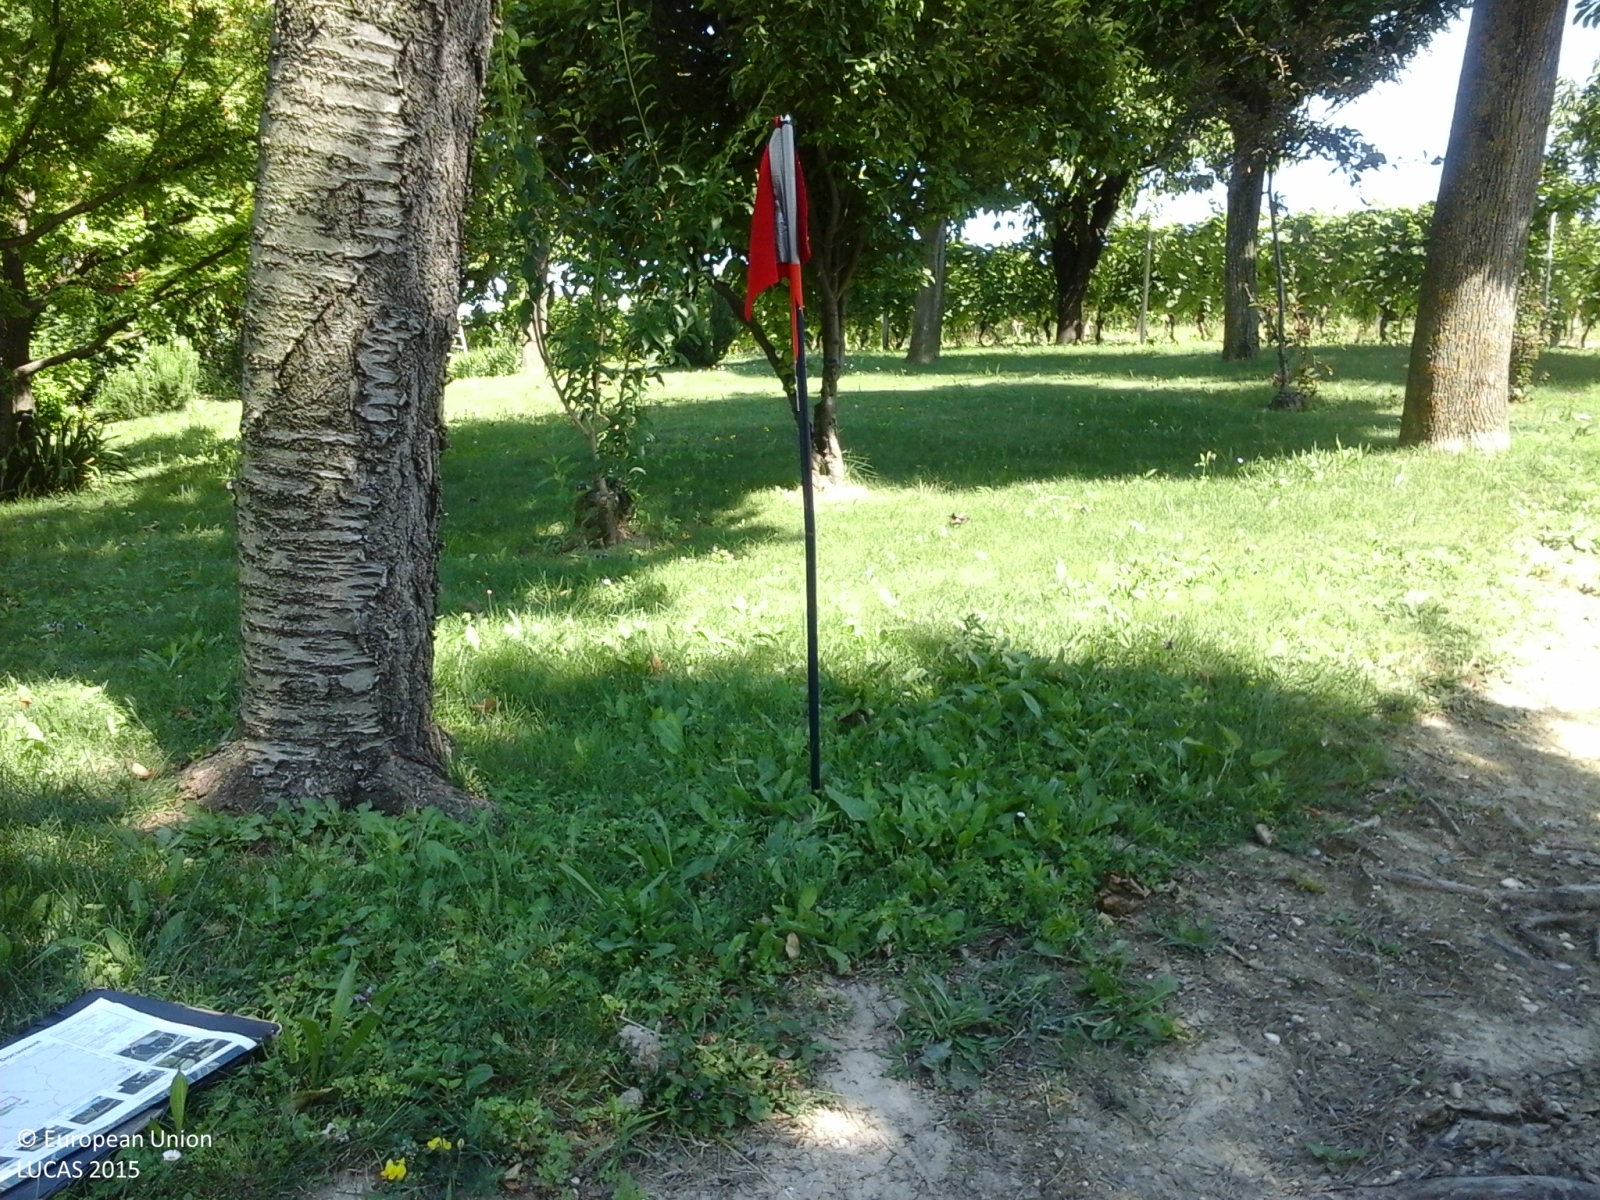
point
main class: Woodland
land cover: Broadleaved woodland
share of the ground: > 75 %
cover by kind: broadleaved forest trees 95 %, herbaceous plants 5 %
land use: Residential
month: June
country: IT
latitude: 44.6944
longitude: 8.1236
